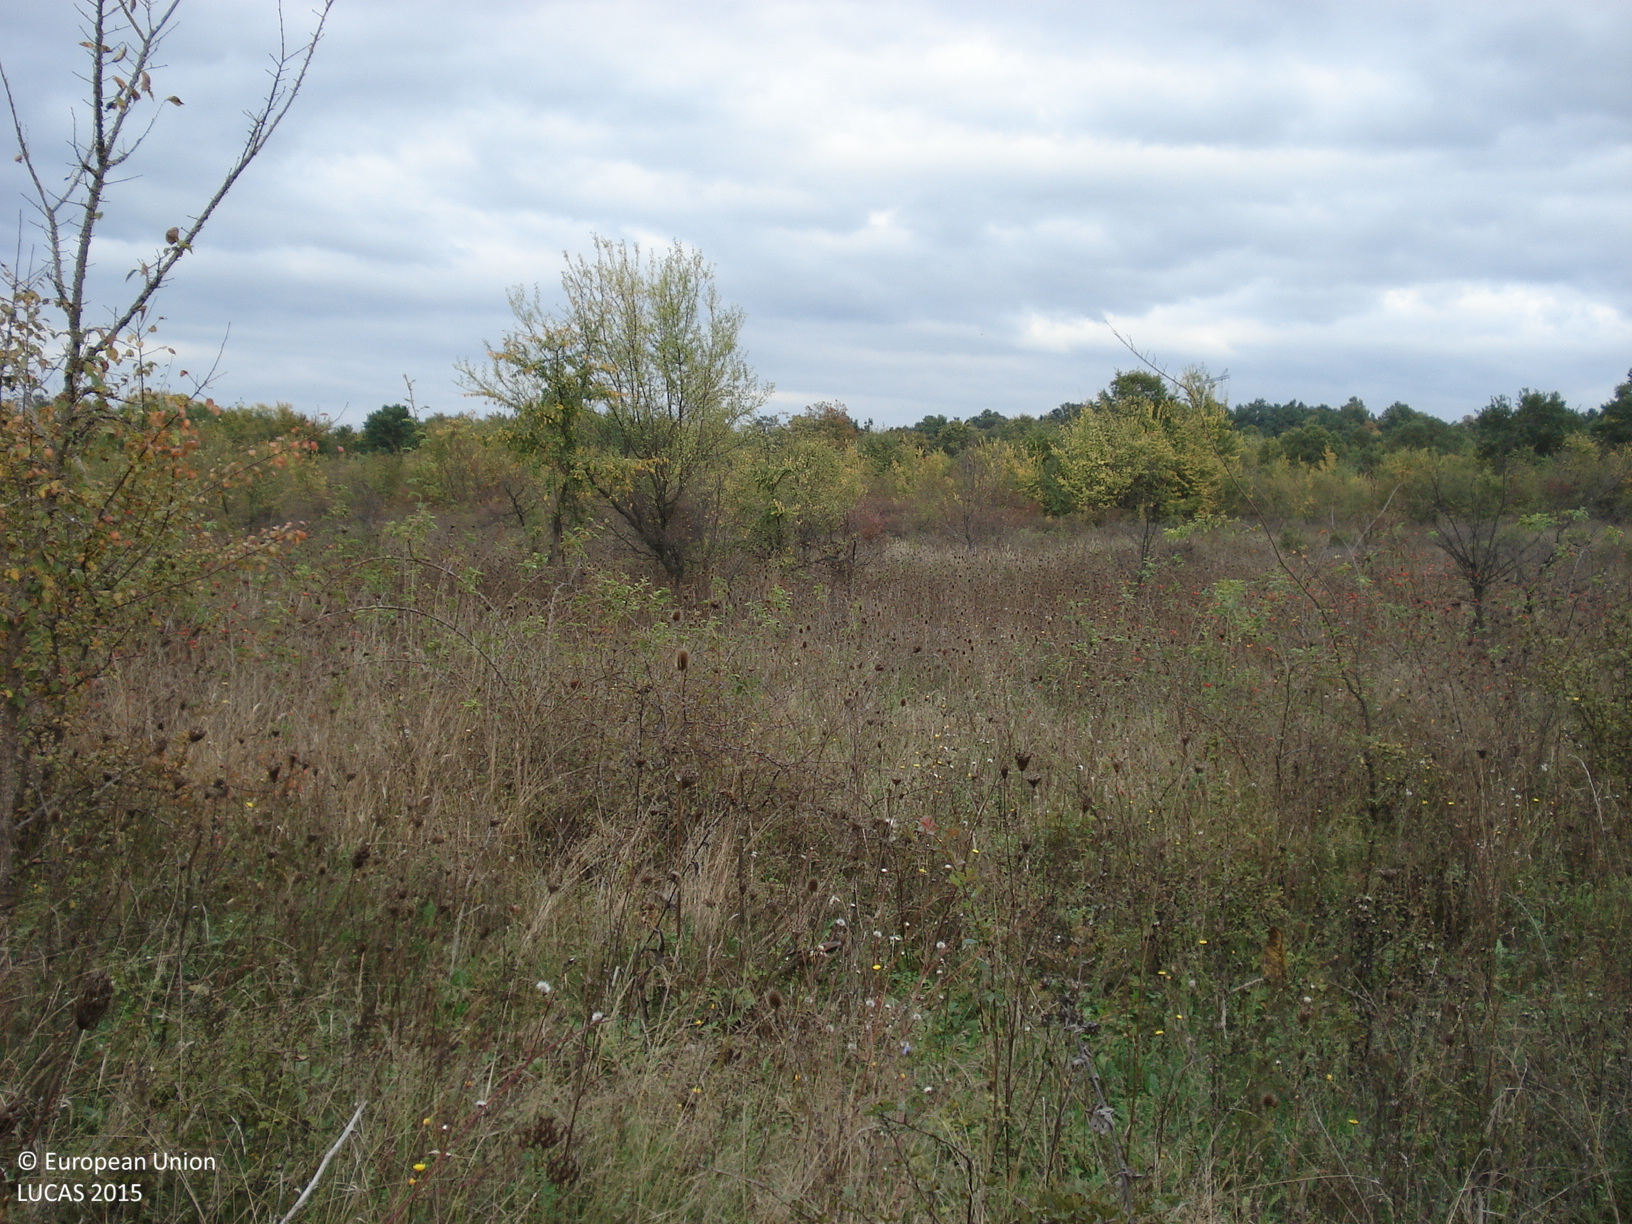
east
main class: Woodland
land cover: Broadleaved woodland
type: mesophytic deciduous forest
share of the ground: > 75 %
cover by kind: broadleaved forest trees 80 %, shrubs 10 %, herbaceous plants 10 %
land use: Forestry
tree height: > 5 m
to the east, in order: Broadleaved woodland; Shrubland with sparse tree cover; Tracks; Shrubland with sparse tree cover; Broadleaved woodland
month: October
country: BG
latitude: 42.9928
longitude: 25.7439
